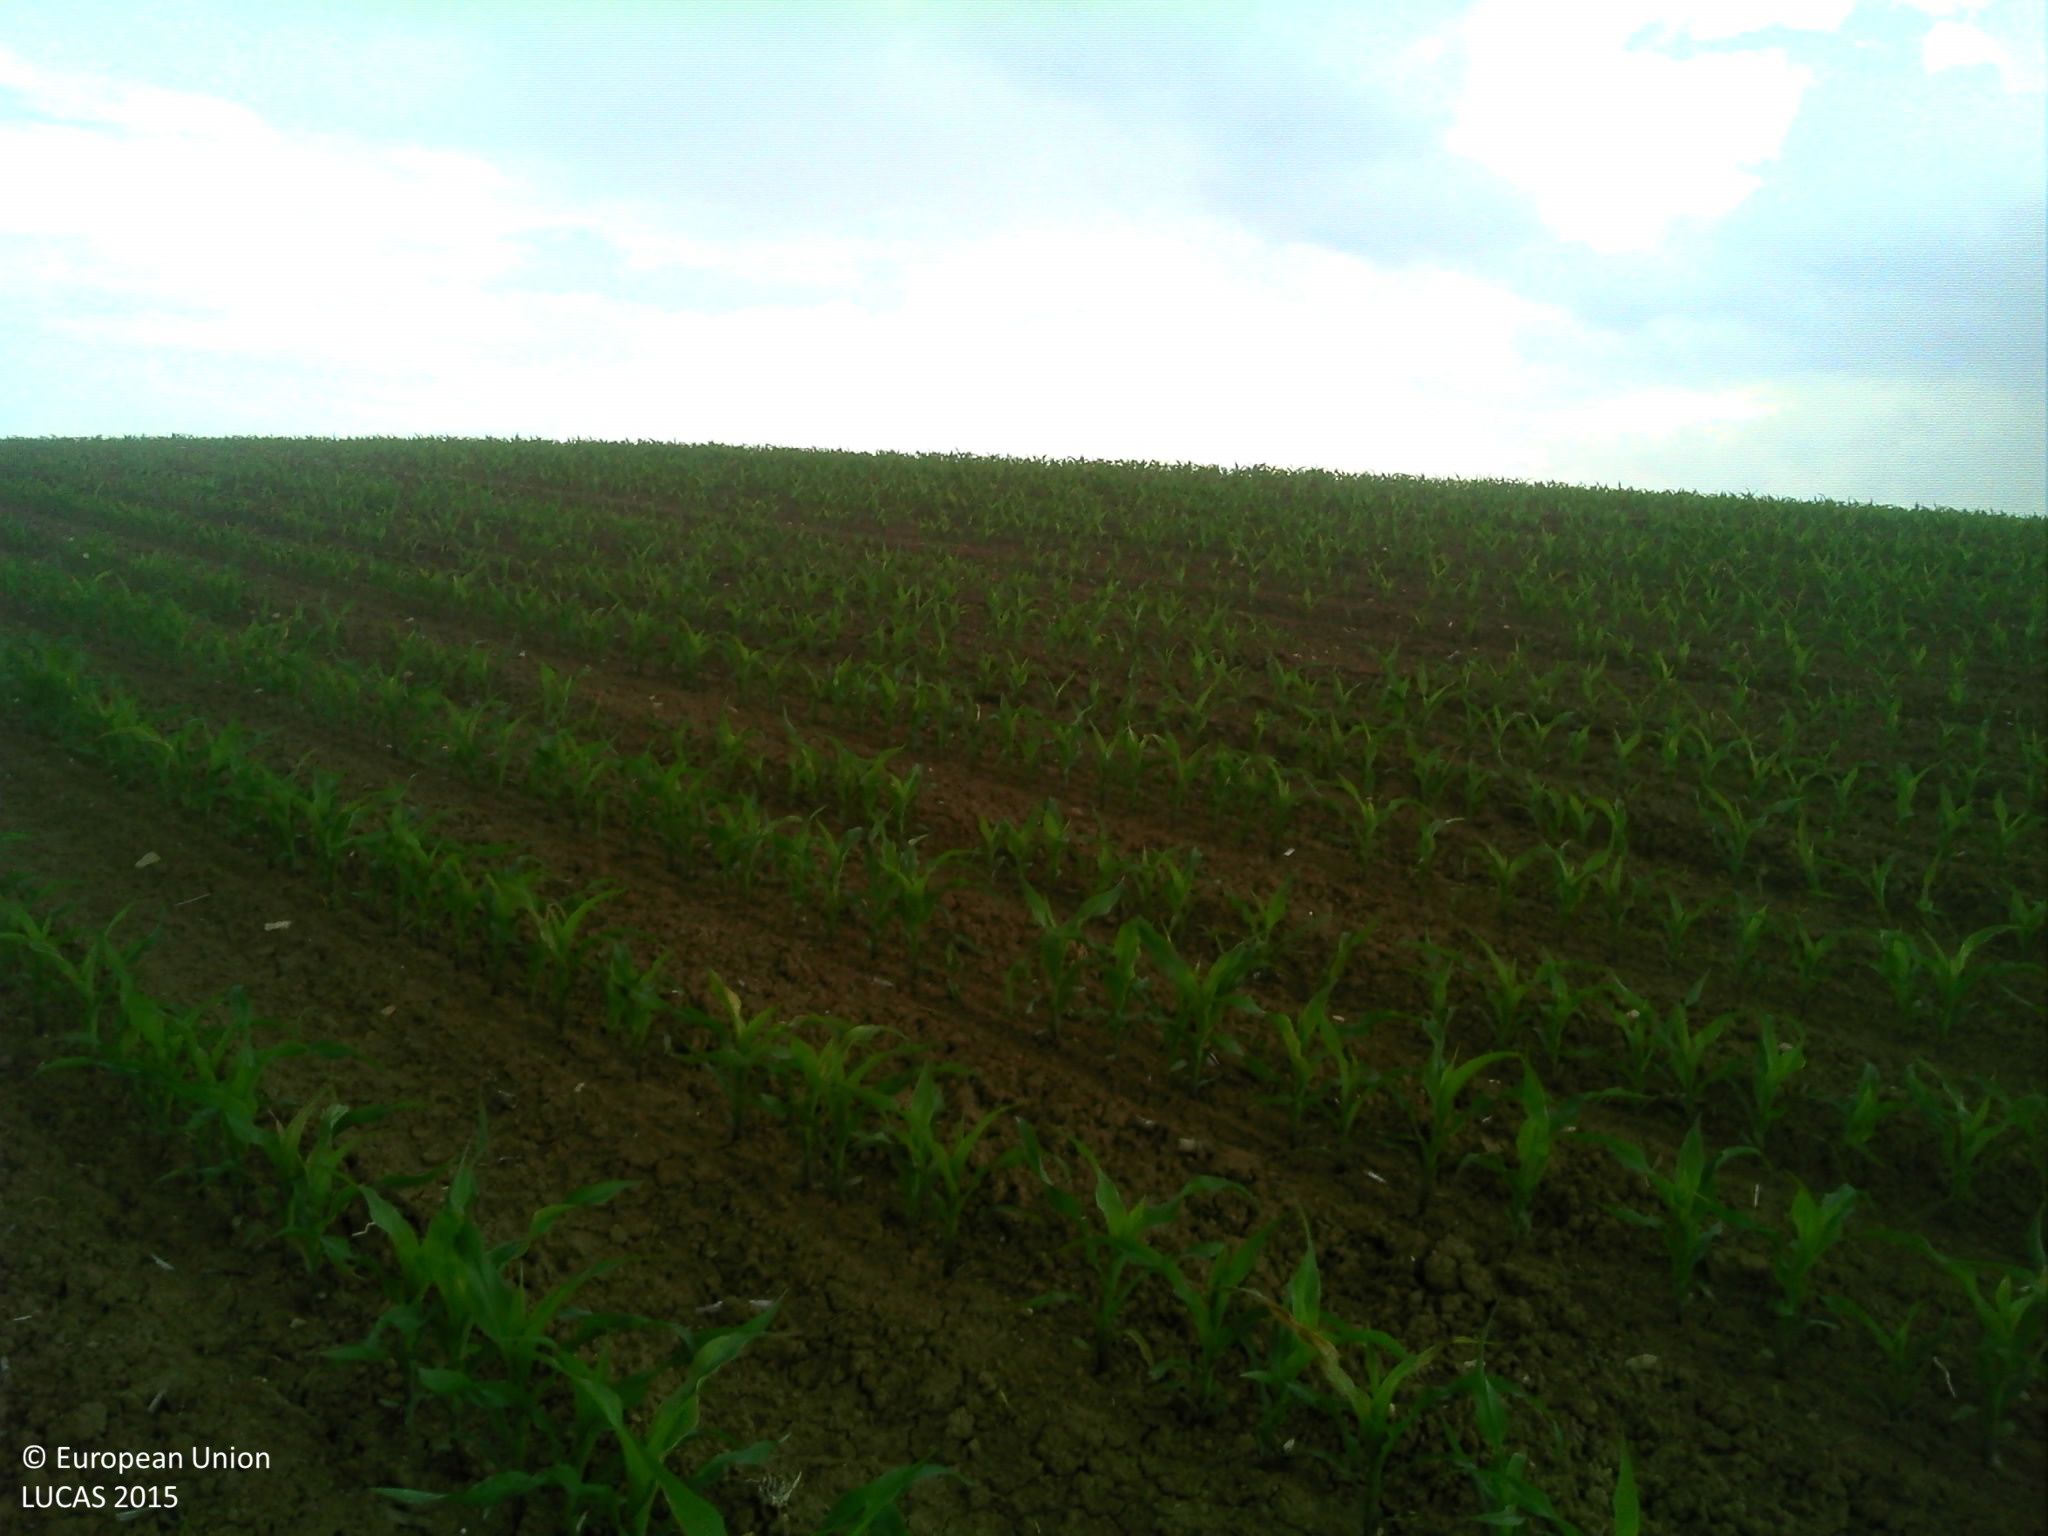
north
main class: Cropland
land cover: Maize
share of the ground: 10 - 25 %
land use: Agriculture (excluding fallow land and kitchen gardens)
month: May
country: FR
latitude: 48.6990
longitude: 7.4871
